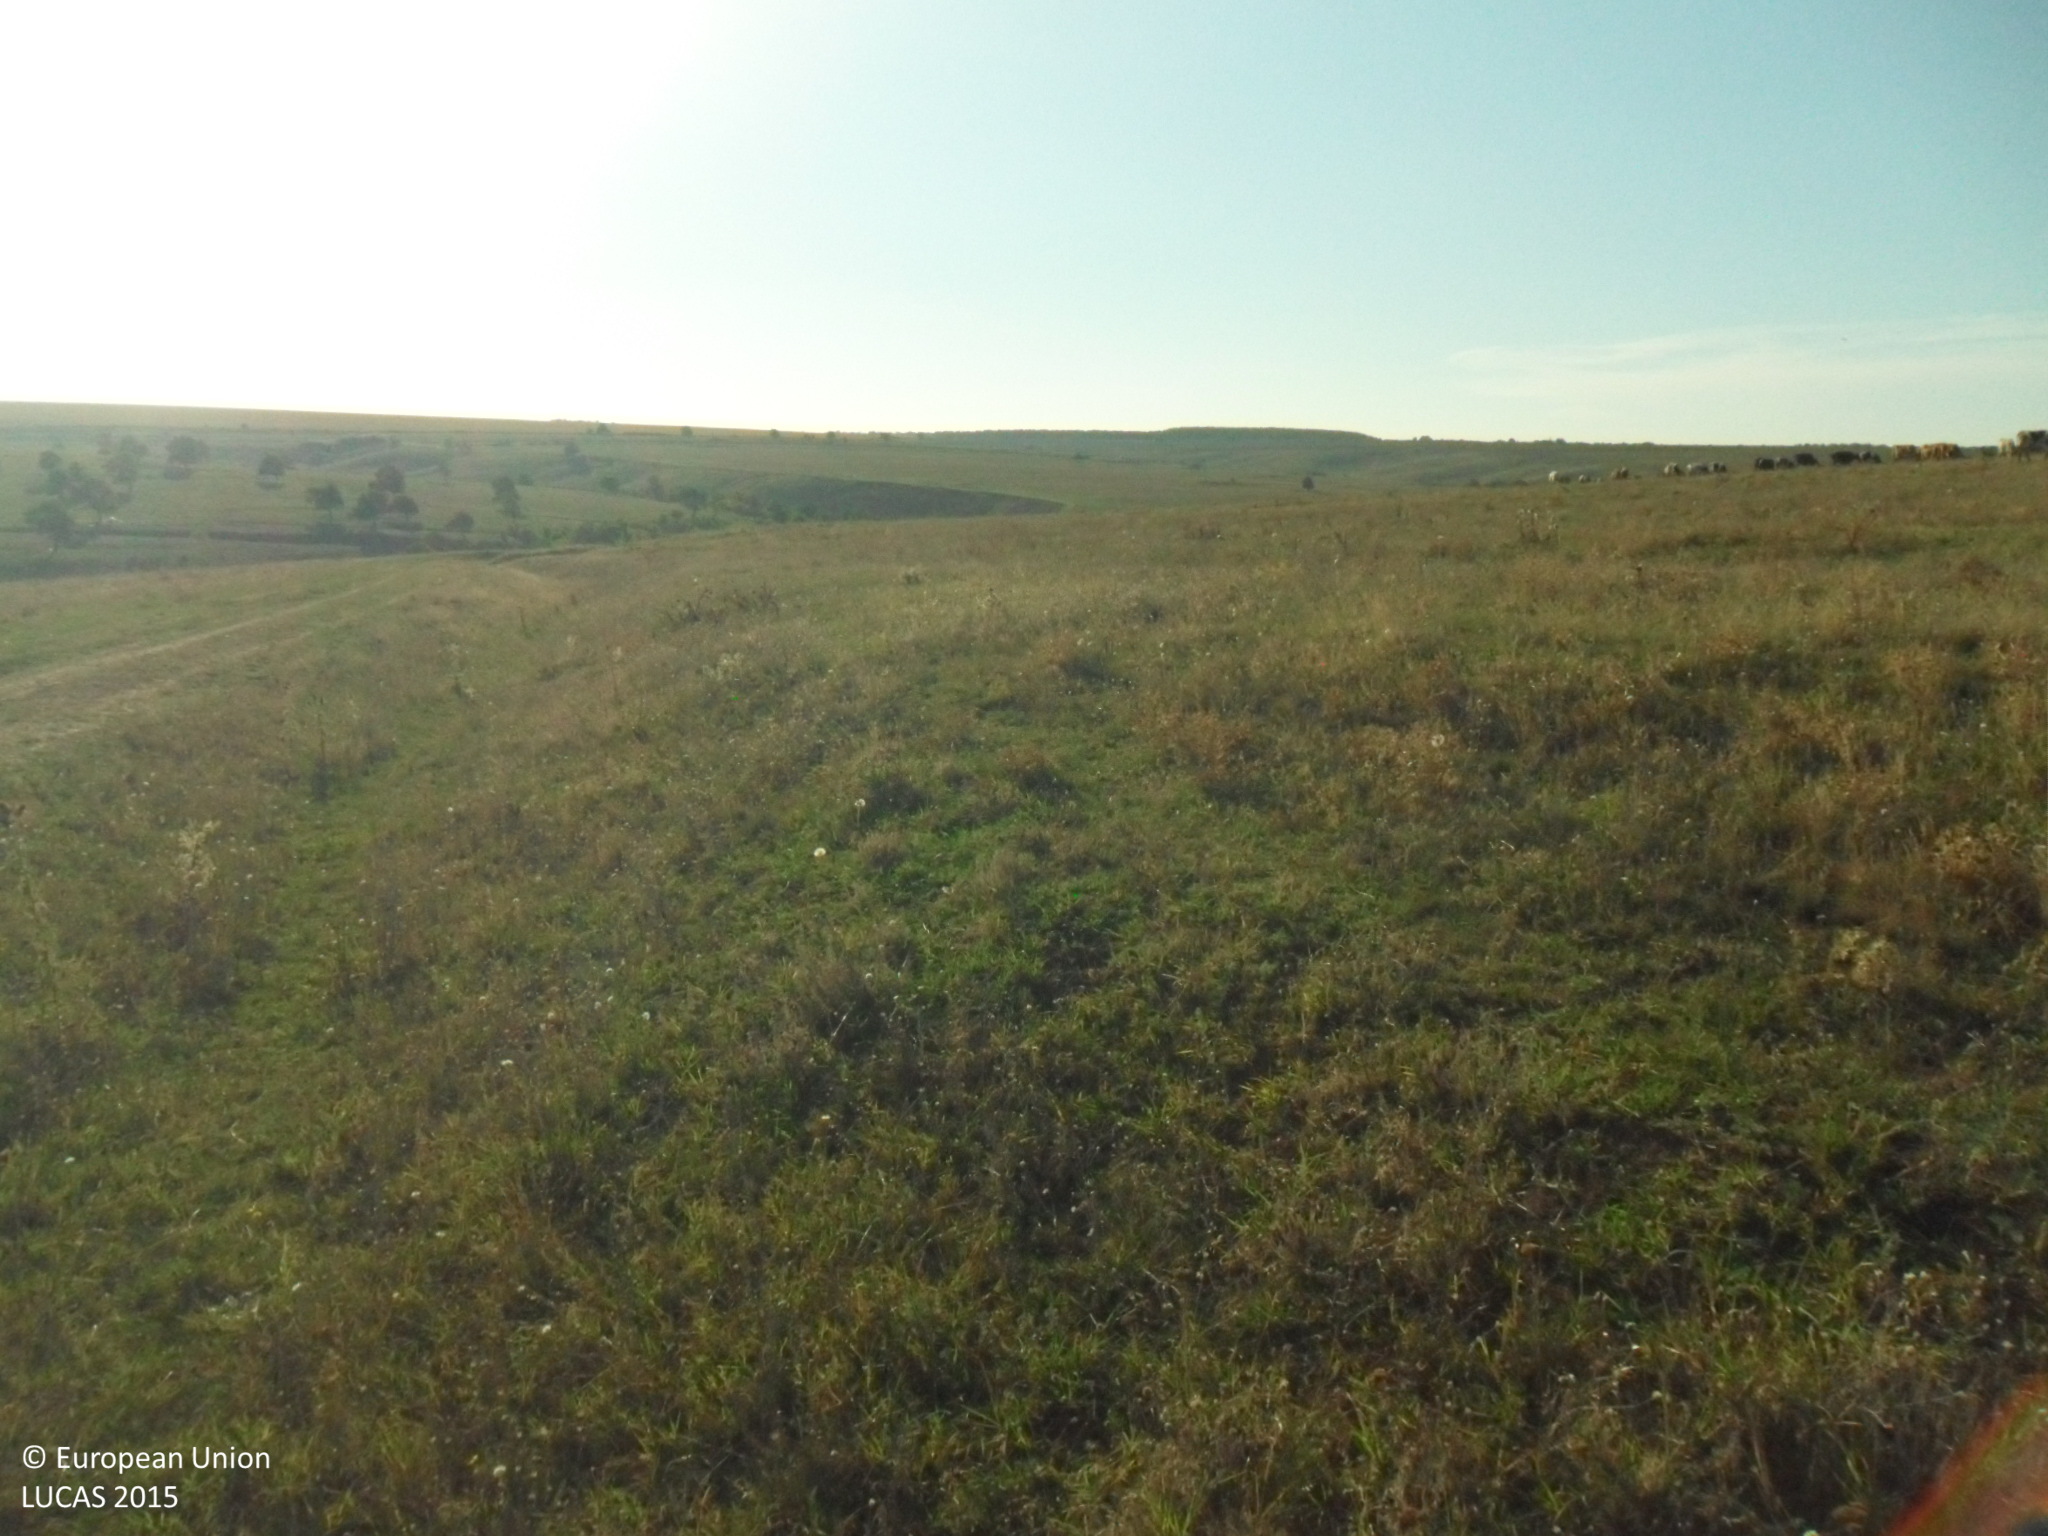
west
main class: Grassland
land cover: Grassland without tree/shrub cover
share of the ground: > 75 %
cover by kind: herbaceous plants 100 %
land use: Agriculture (excluding fallow land and kitchen gardens)
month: September
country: BG
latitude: 43.4513
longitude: 27.2130
